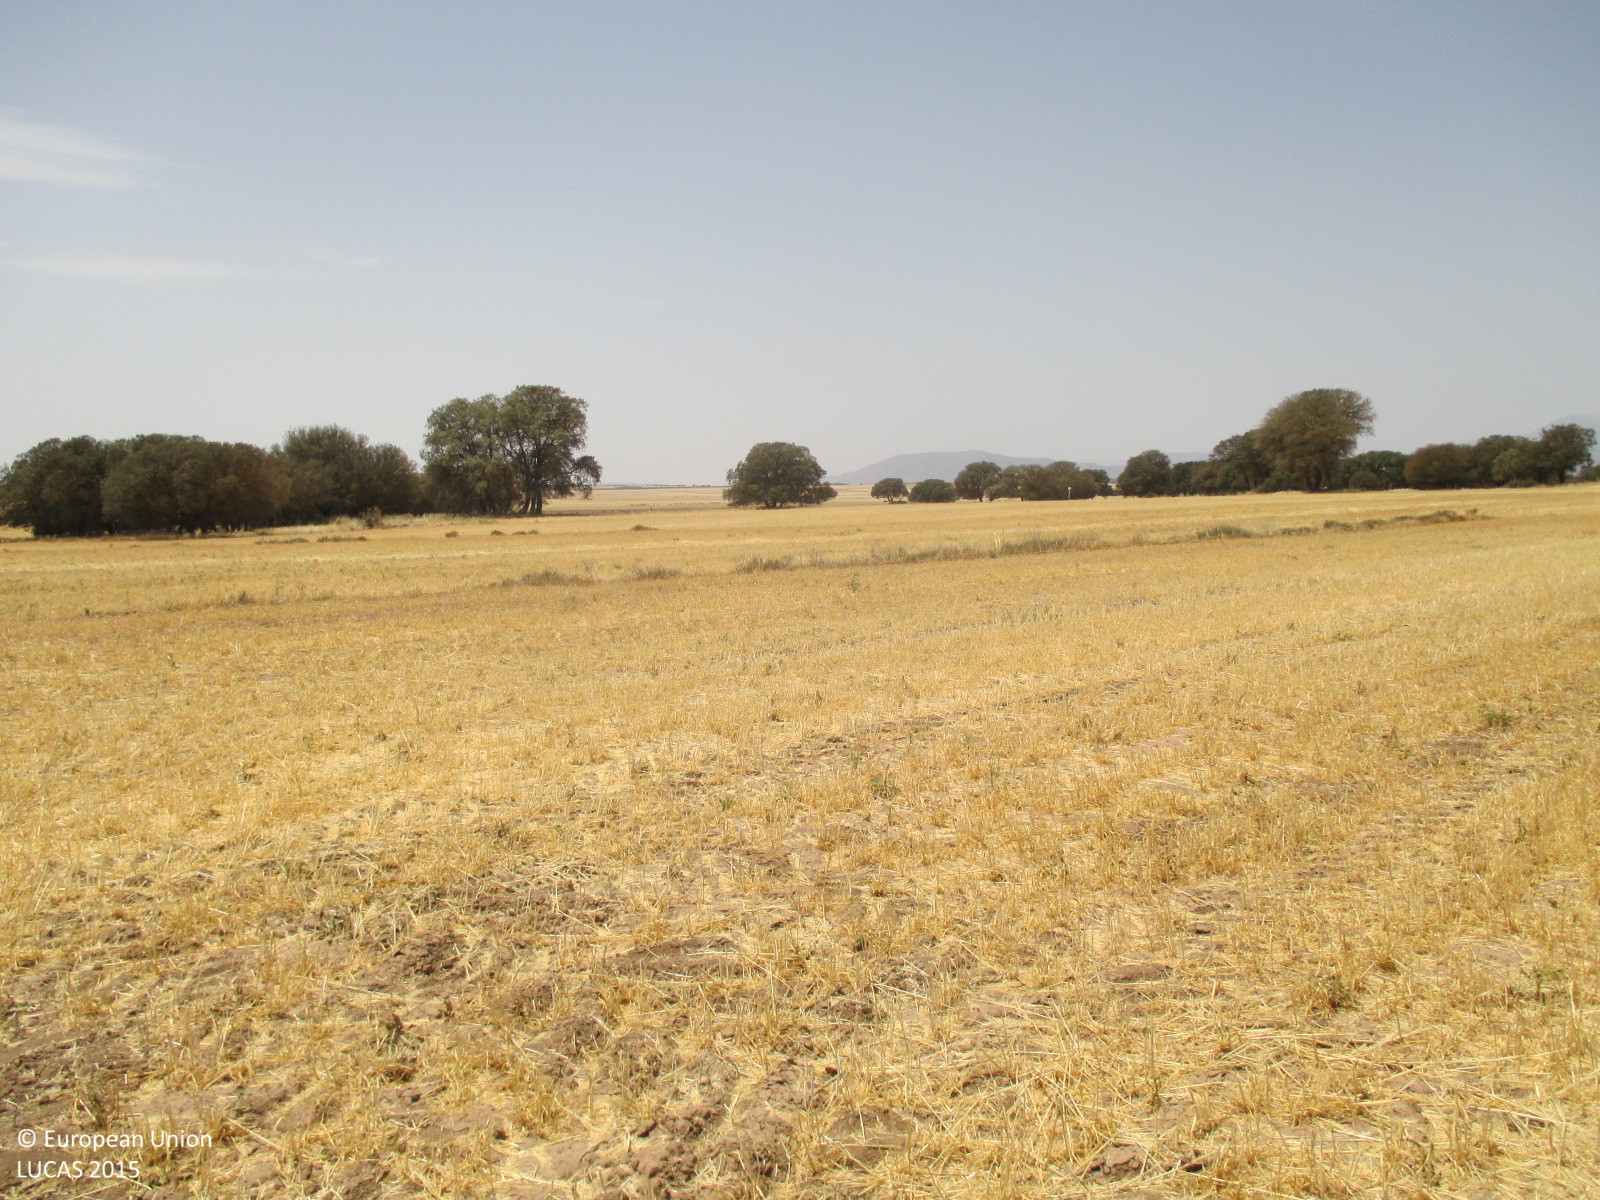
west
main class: Cropland
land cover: Barley
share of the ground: < 10 %
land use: Agriculture (excluding fallow land and kitchen gardens)
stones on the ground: < 10 %
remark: Harvested field
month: July
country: ES
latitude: 37.8469
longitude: -2.2734
